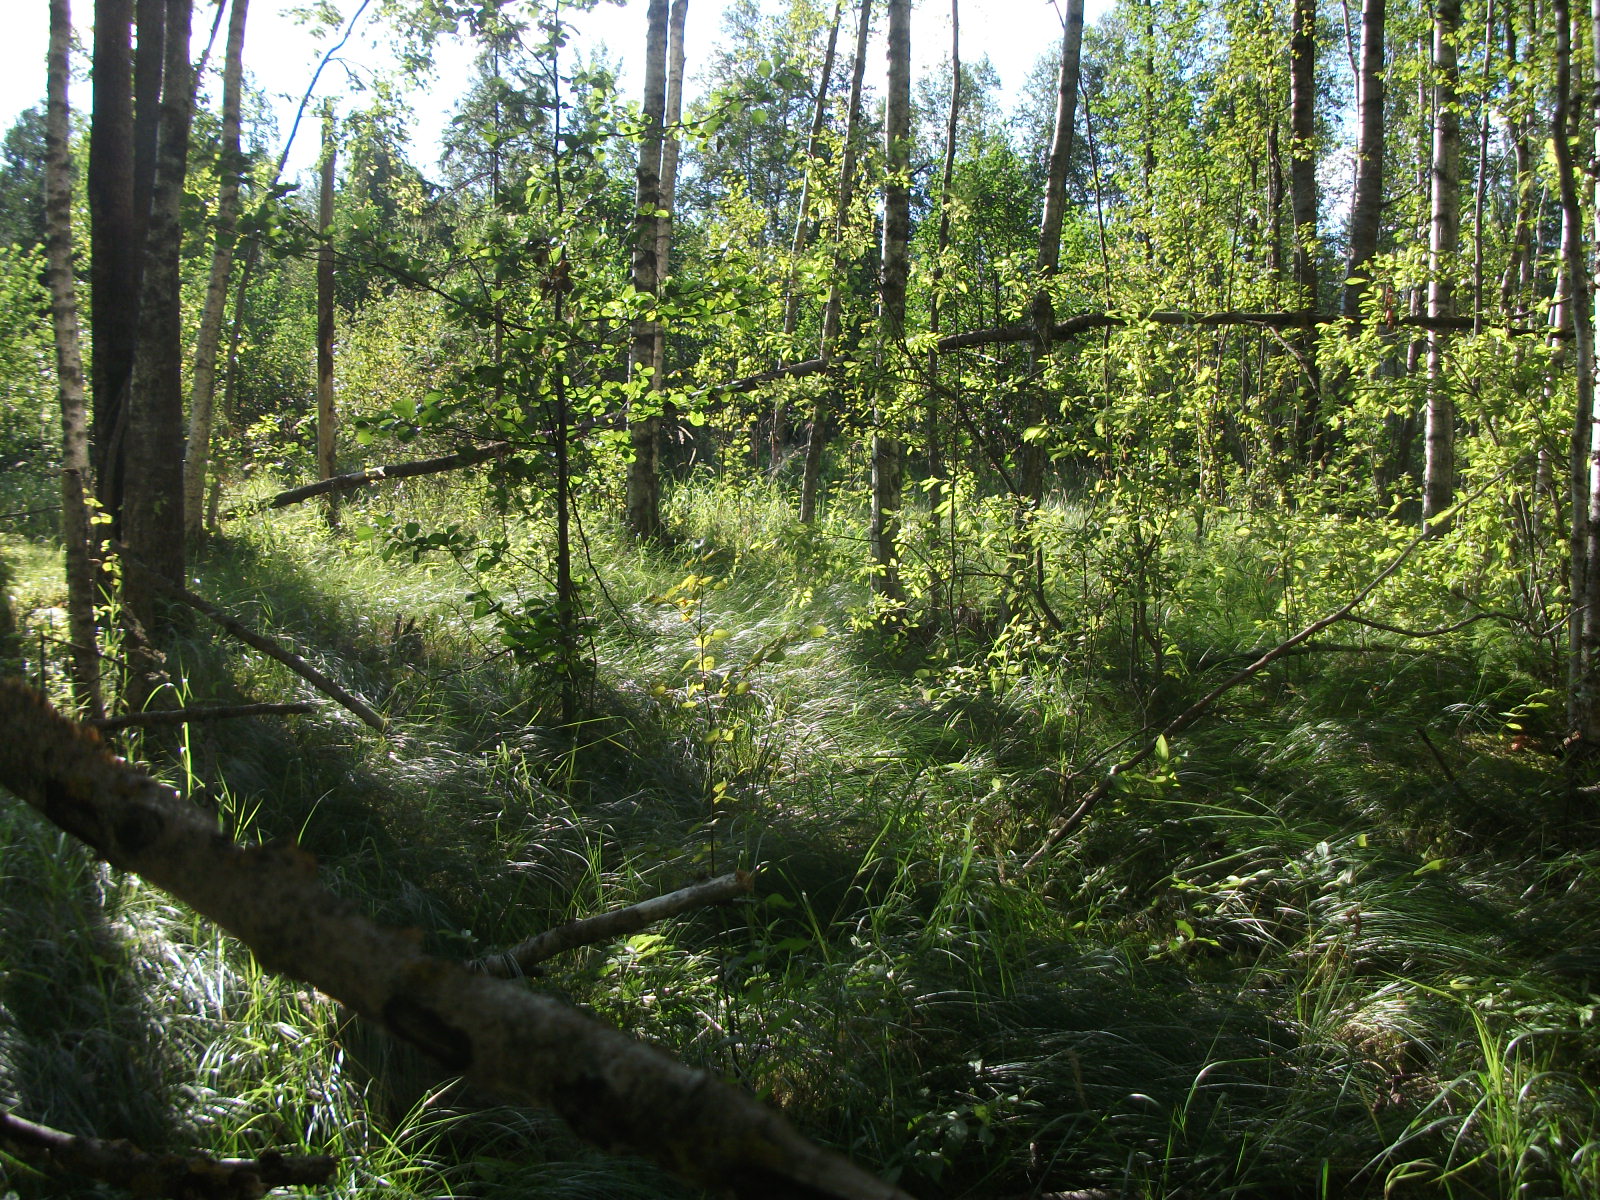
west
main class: Woodland
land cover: Broadleaved woodland
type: mire and swamp forests
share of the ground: > 75 %
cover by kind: broadleaved forest trees 85 %, lichens and mosses 10 %, herbaceous plants 5 %
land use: Forestry
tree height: > 5 m
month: August
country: LV
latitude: 56.5181
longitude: 26.4146
